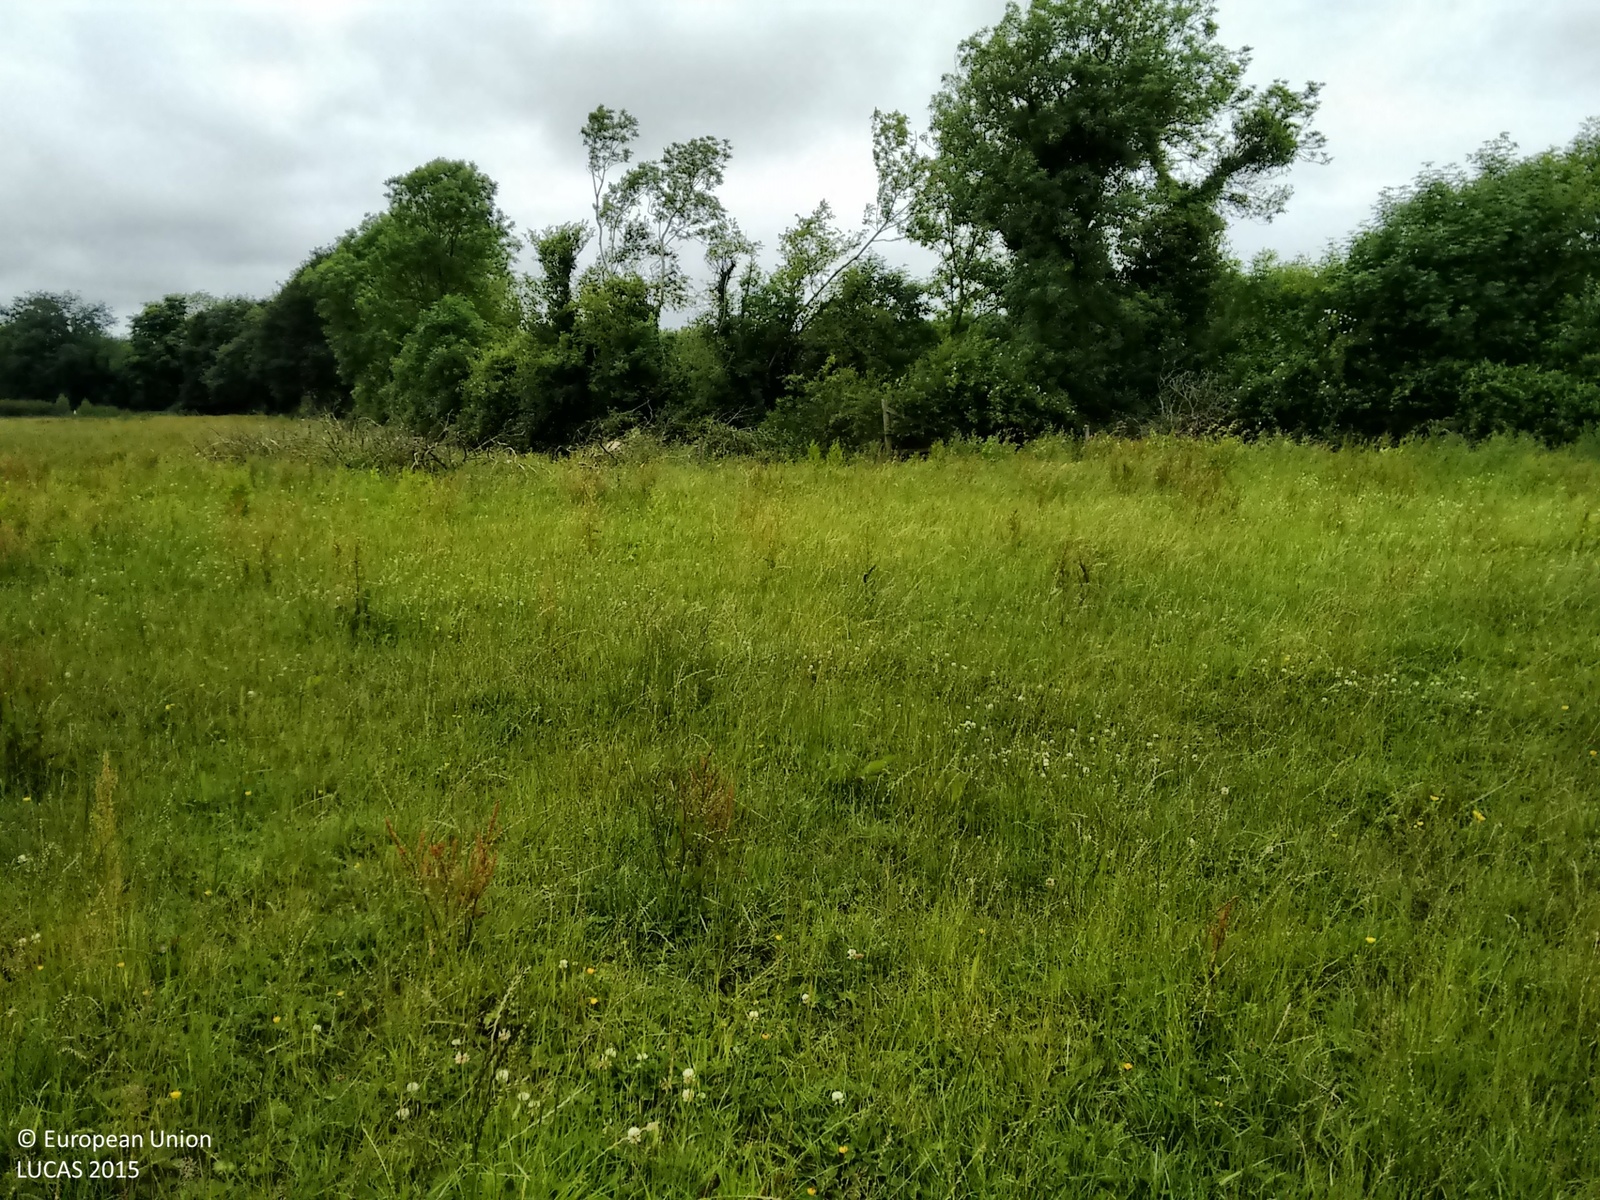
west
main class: Grassland
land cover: Grassland without tree/shrub cover
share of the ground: > 75 %
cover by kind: herbaceous plants 100 %
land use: Agriculture (excluding fallow land and kitchen gardens)
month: July
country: IE
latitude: 52.4989
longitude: -8.2289
